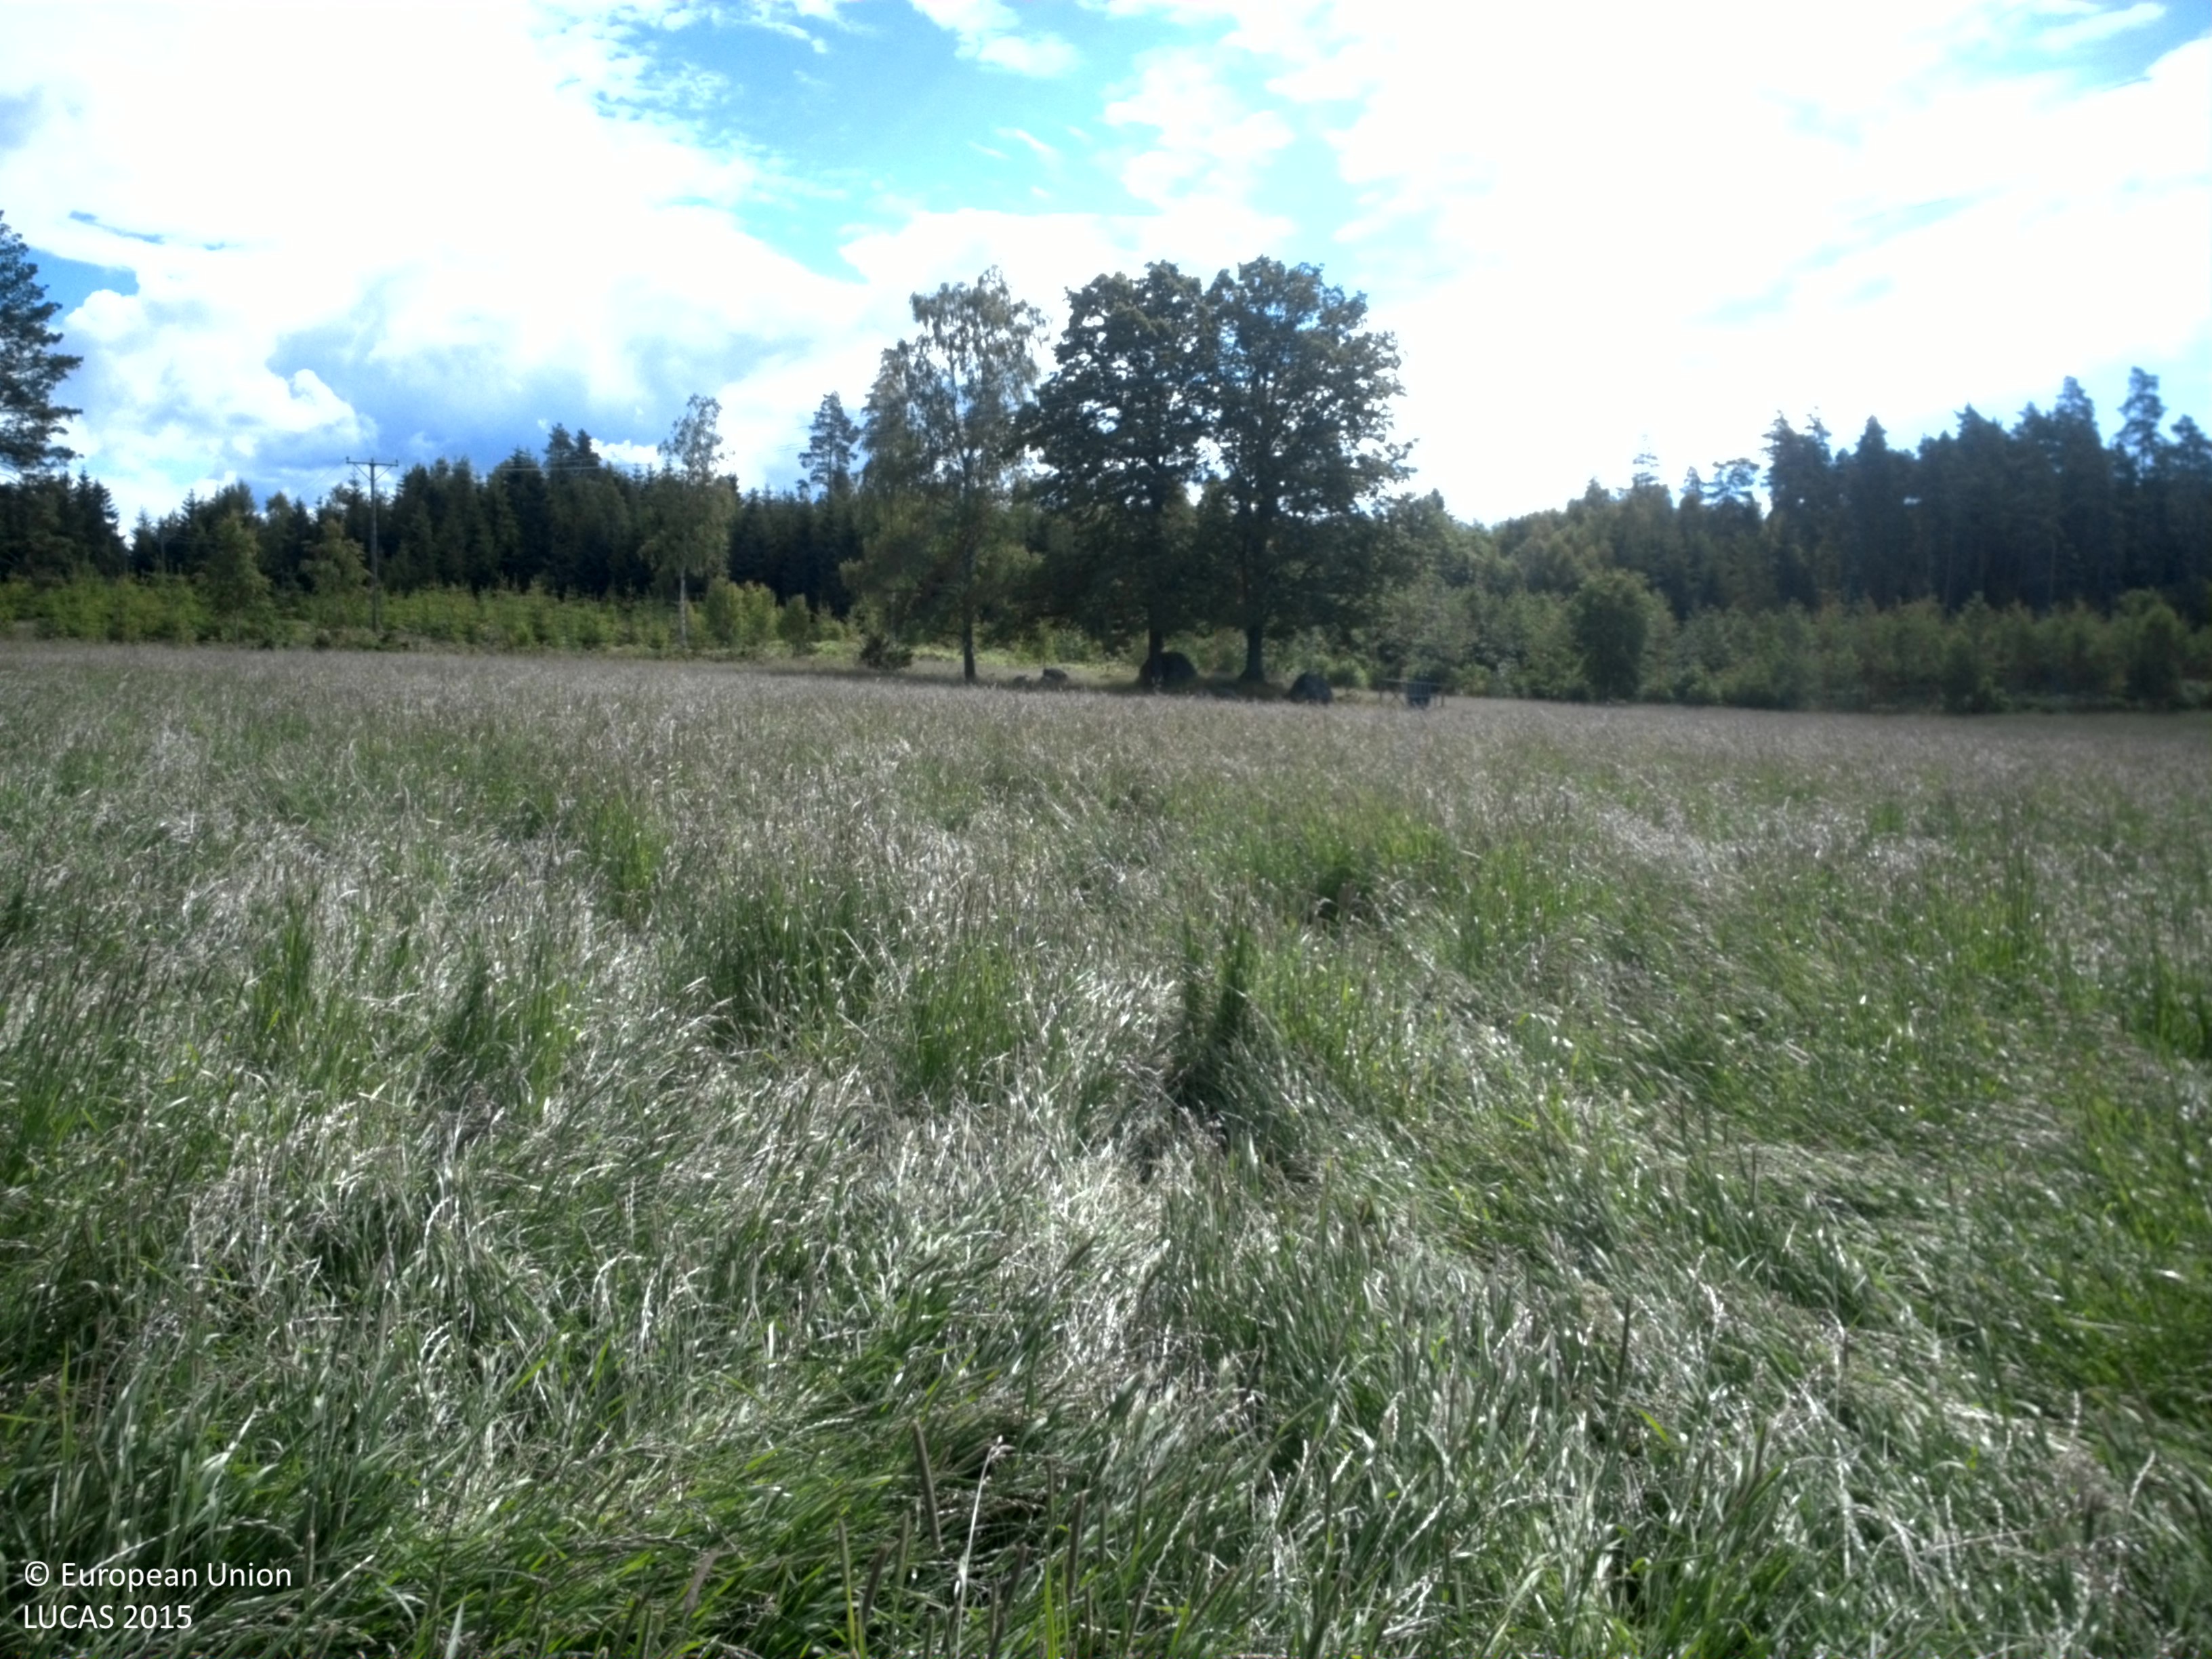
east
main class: Cropland
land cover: Temporary grasslands
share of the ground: > 75 %
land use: Agriculture (excluding fallow land and kitchen gardens)
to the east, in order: Temporary grasslands; Electric lines; Temporary grasslands; Broadleaved woodland; Temporary grasslands; Broadleaved woodland; Spruce dominated coniferous woodland
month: June
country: SE
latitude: 58.5395
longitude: 15.5084
